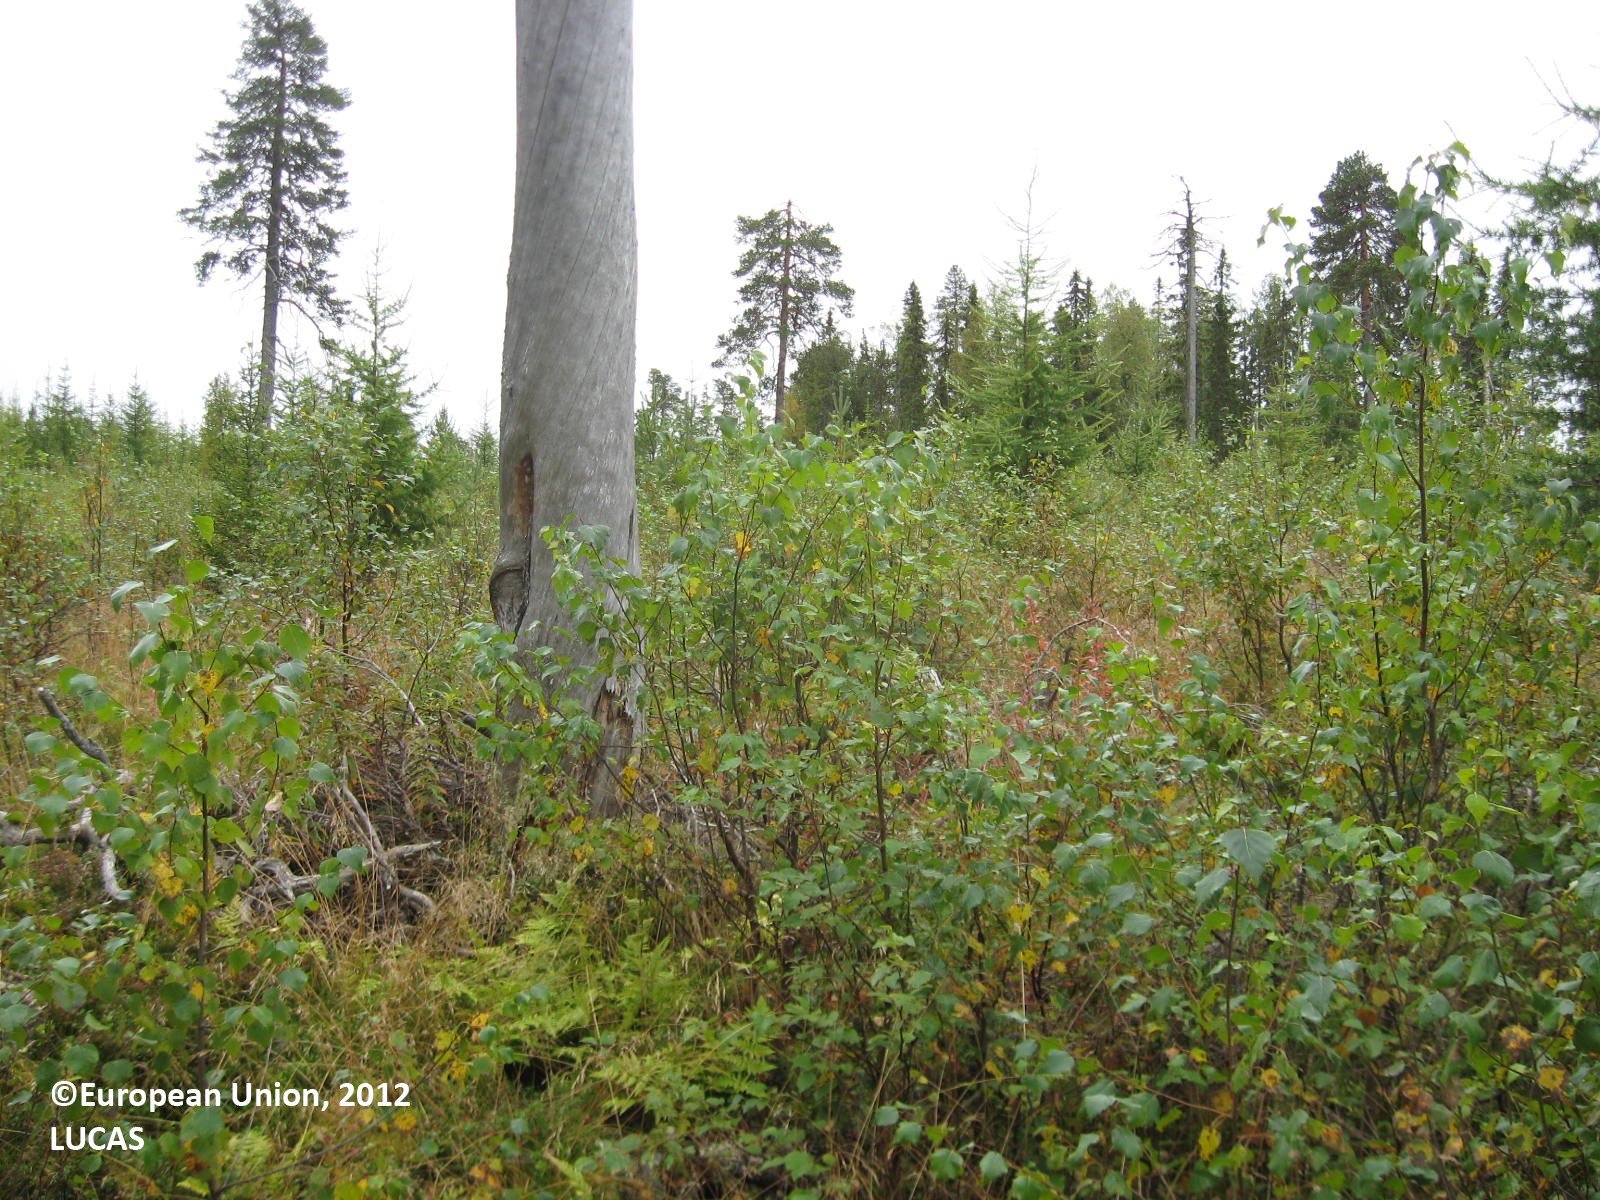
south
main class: Woodland
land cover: Other mixed woodland
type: boreal forest
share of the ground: > 75 %
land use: Forestry
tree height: < 5 m
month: August
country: FI
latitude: 63.8768
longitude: 29.6693
